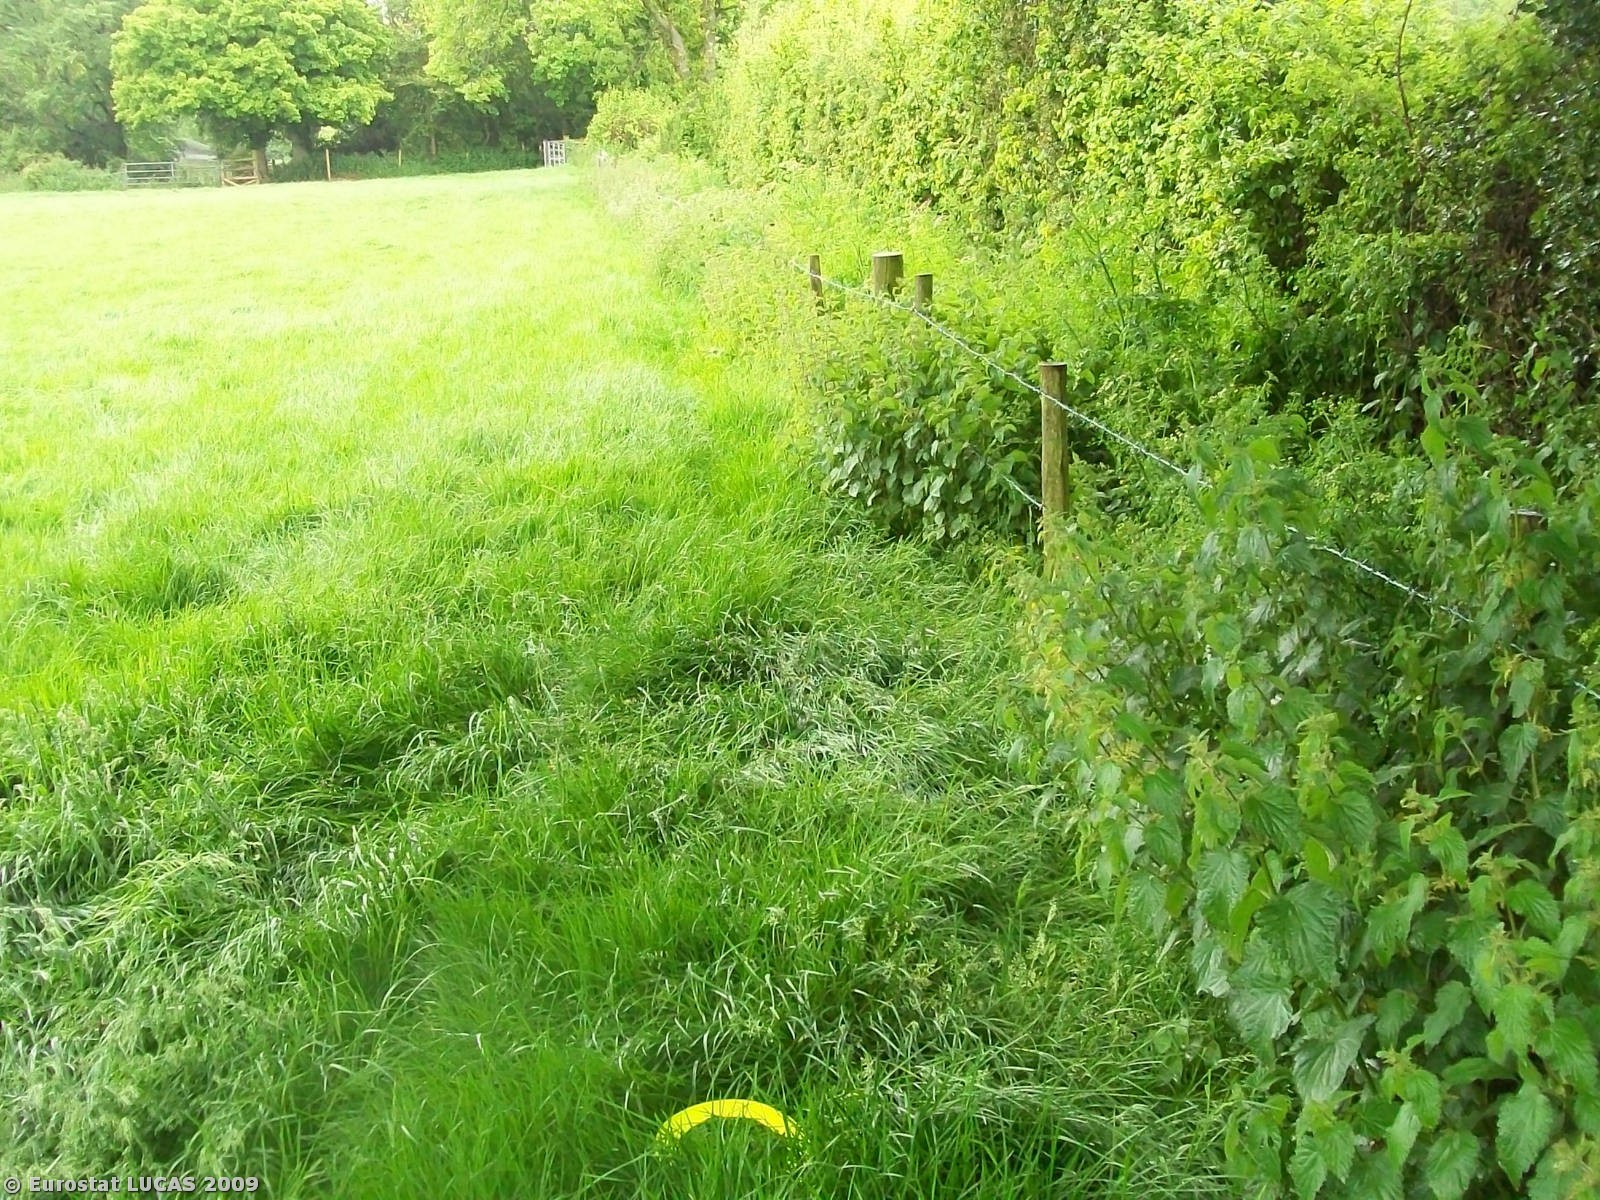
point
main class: Grassland
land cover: Grassland without tree/shrub cover
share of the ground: > 75 %
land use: Agriculture (excluding fallow land and kitchen gardens)
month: May
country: GB
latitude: 50.7636
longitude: -3.3369
